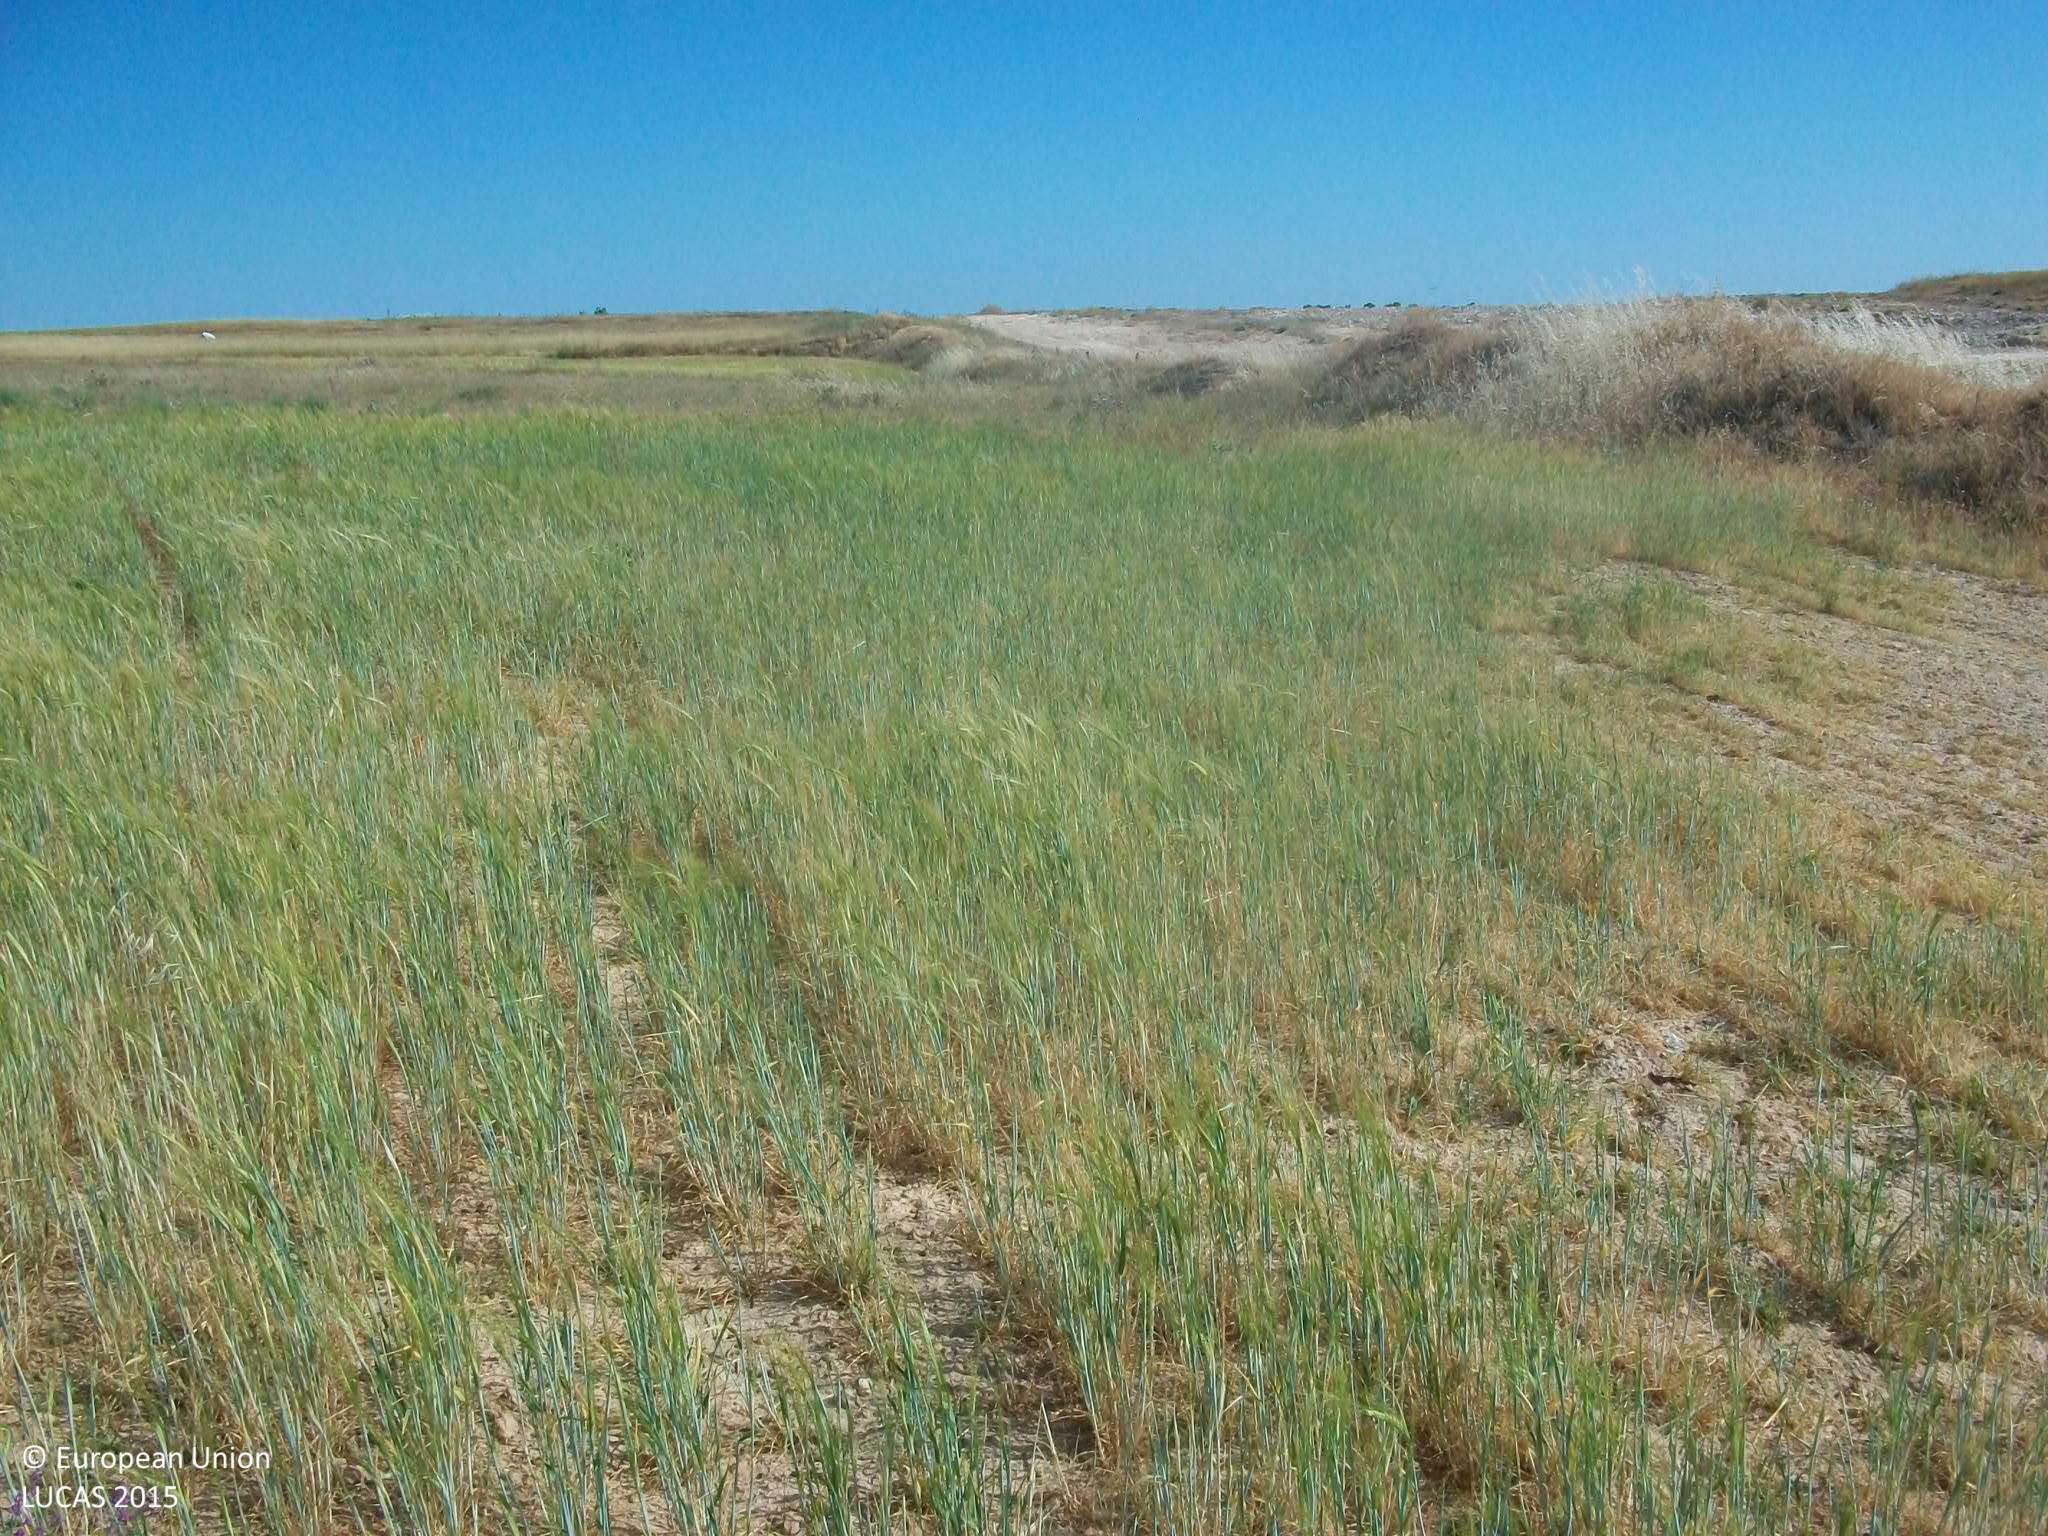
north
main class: Cropland
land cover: Barley
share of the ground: 50 - 75 %
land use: Agriculture (excluding fallow land and kitchen gardens)
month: May
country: ES
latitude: 40.0685
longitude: -3.7162
